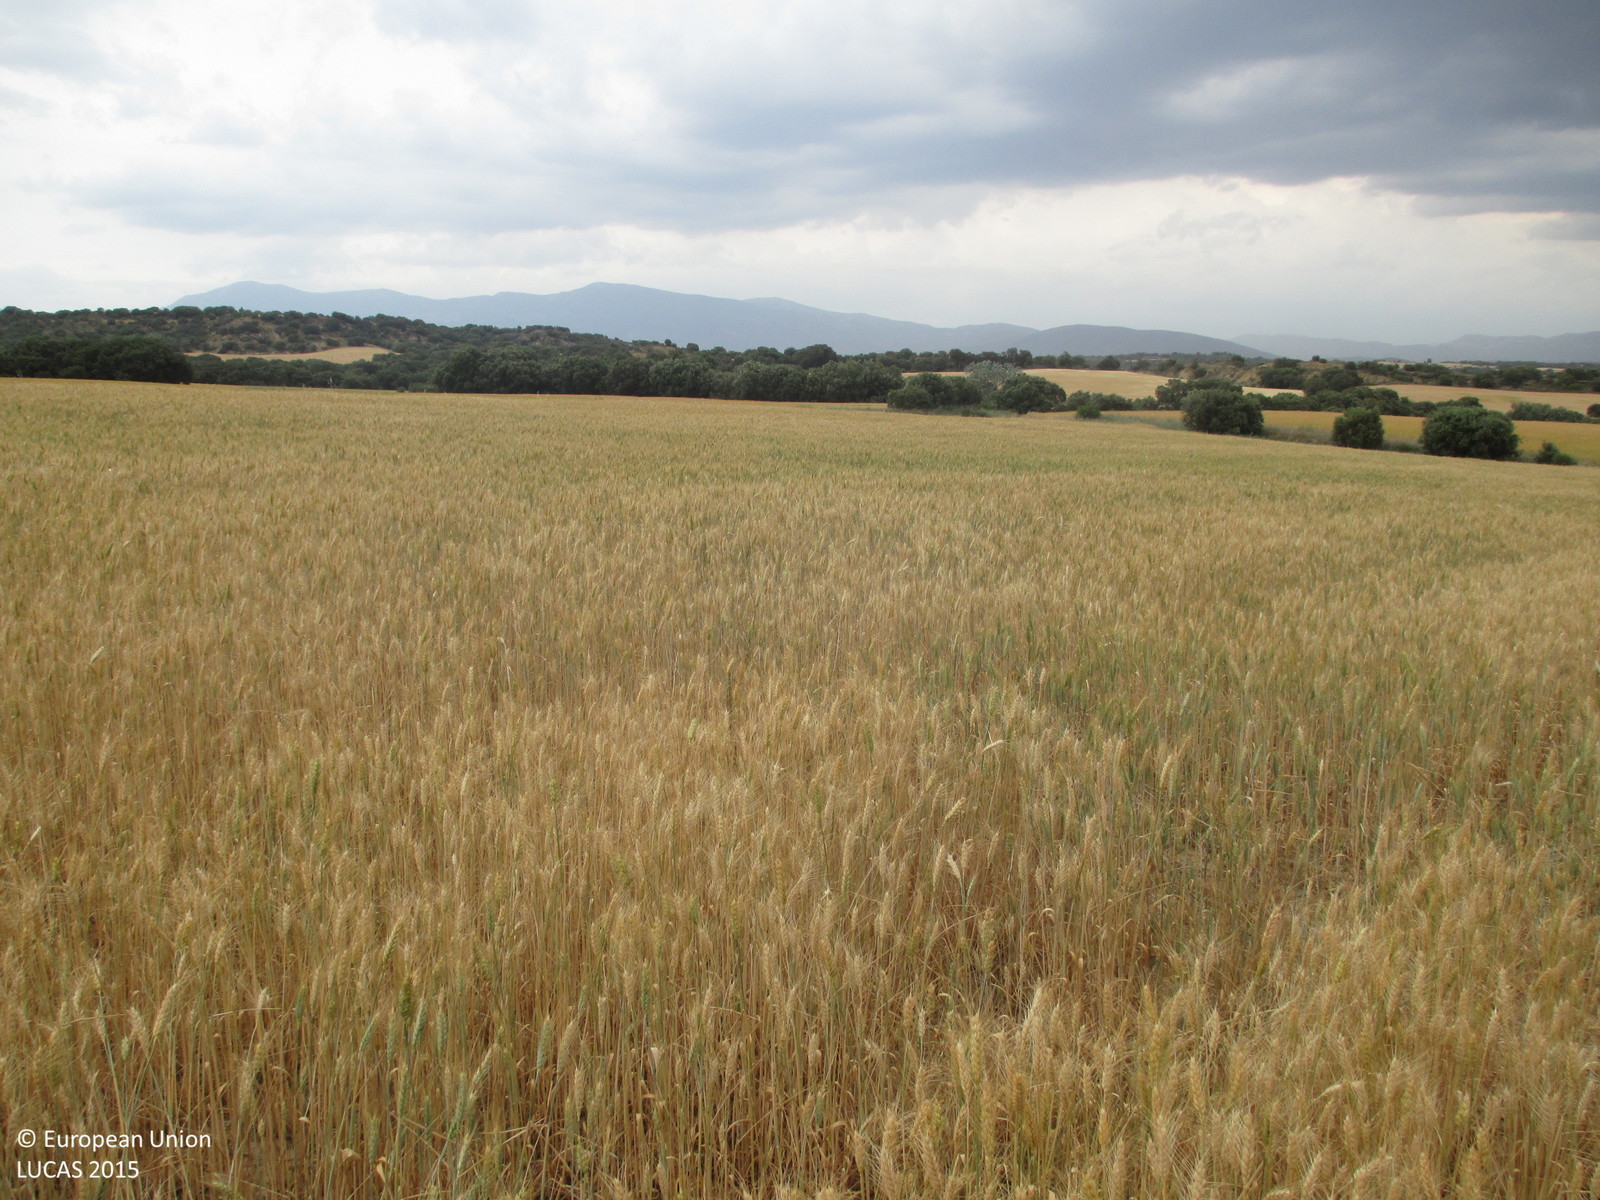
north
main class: Cropland
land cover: Durum wheat
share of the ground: > 75 %
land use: Agriculture (excluding fallow land and kitchen gardens)
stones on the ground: < 10 %
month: May
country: ES
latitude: 42.1203
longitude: -0.1933
